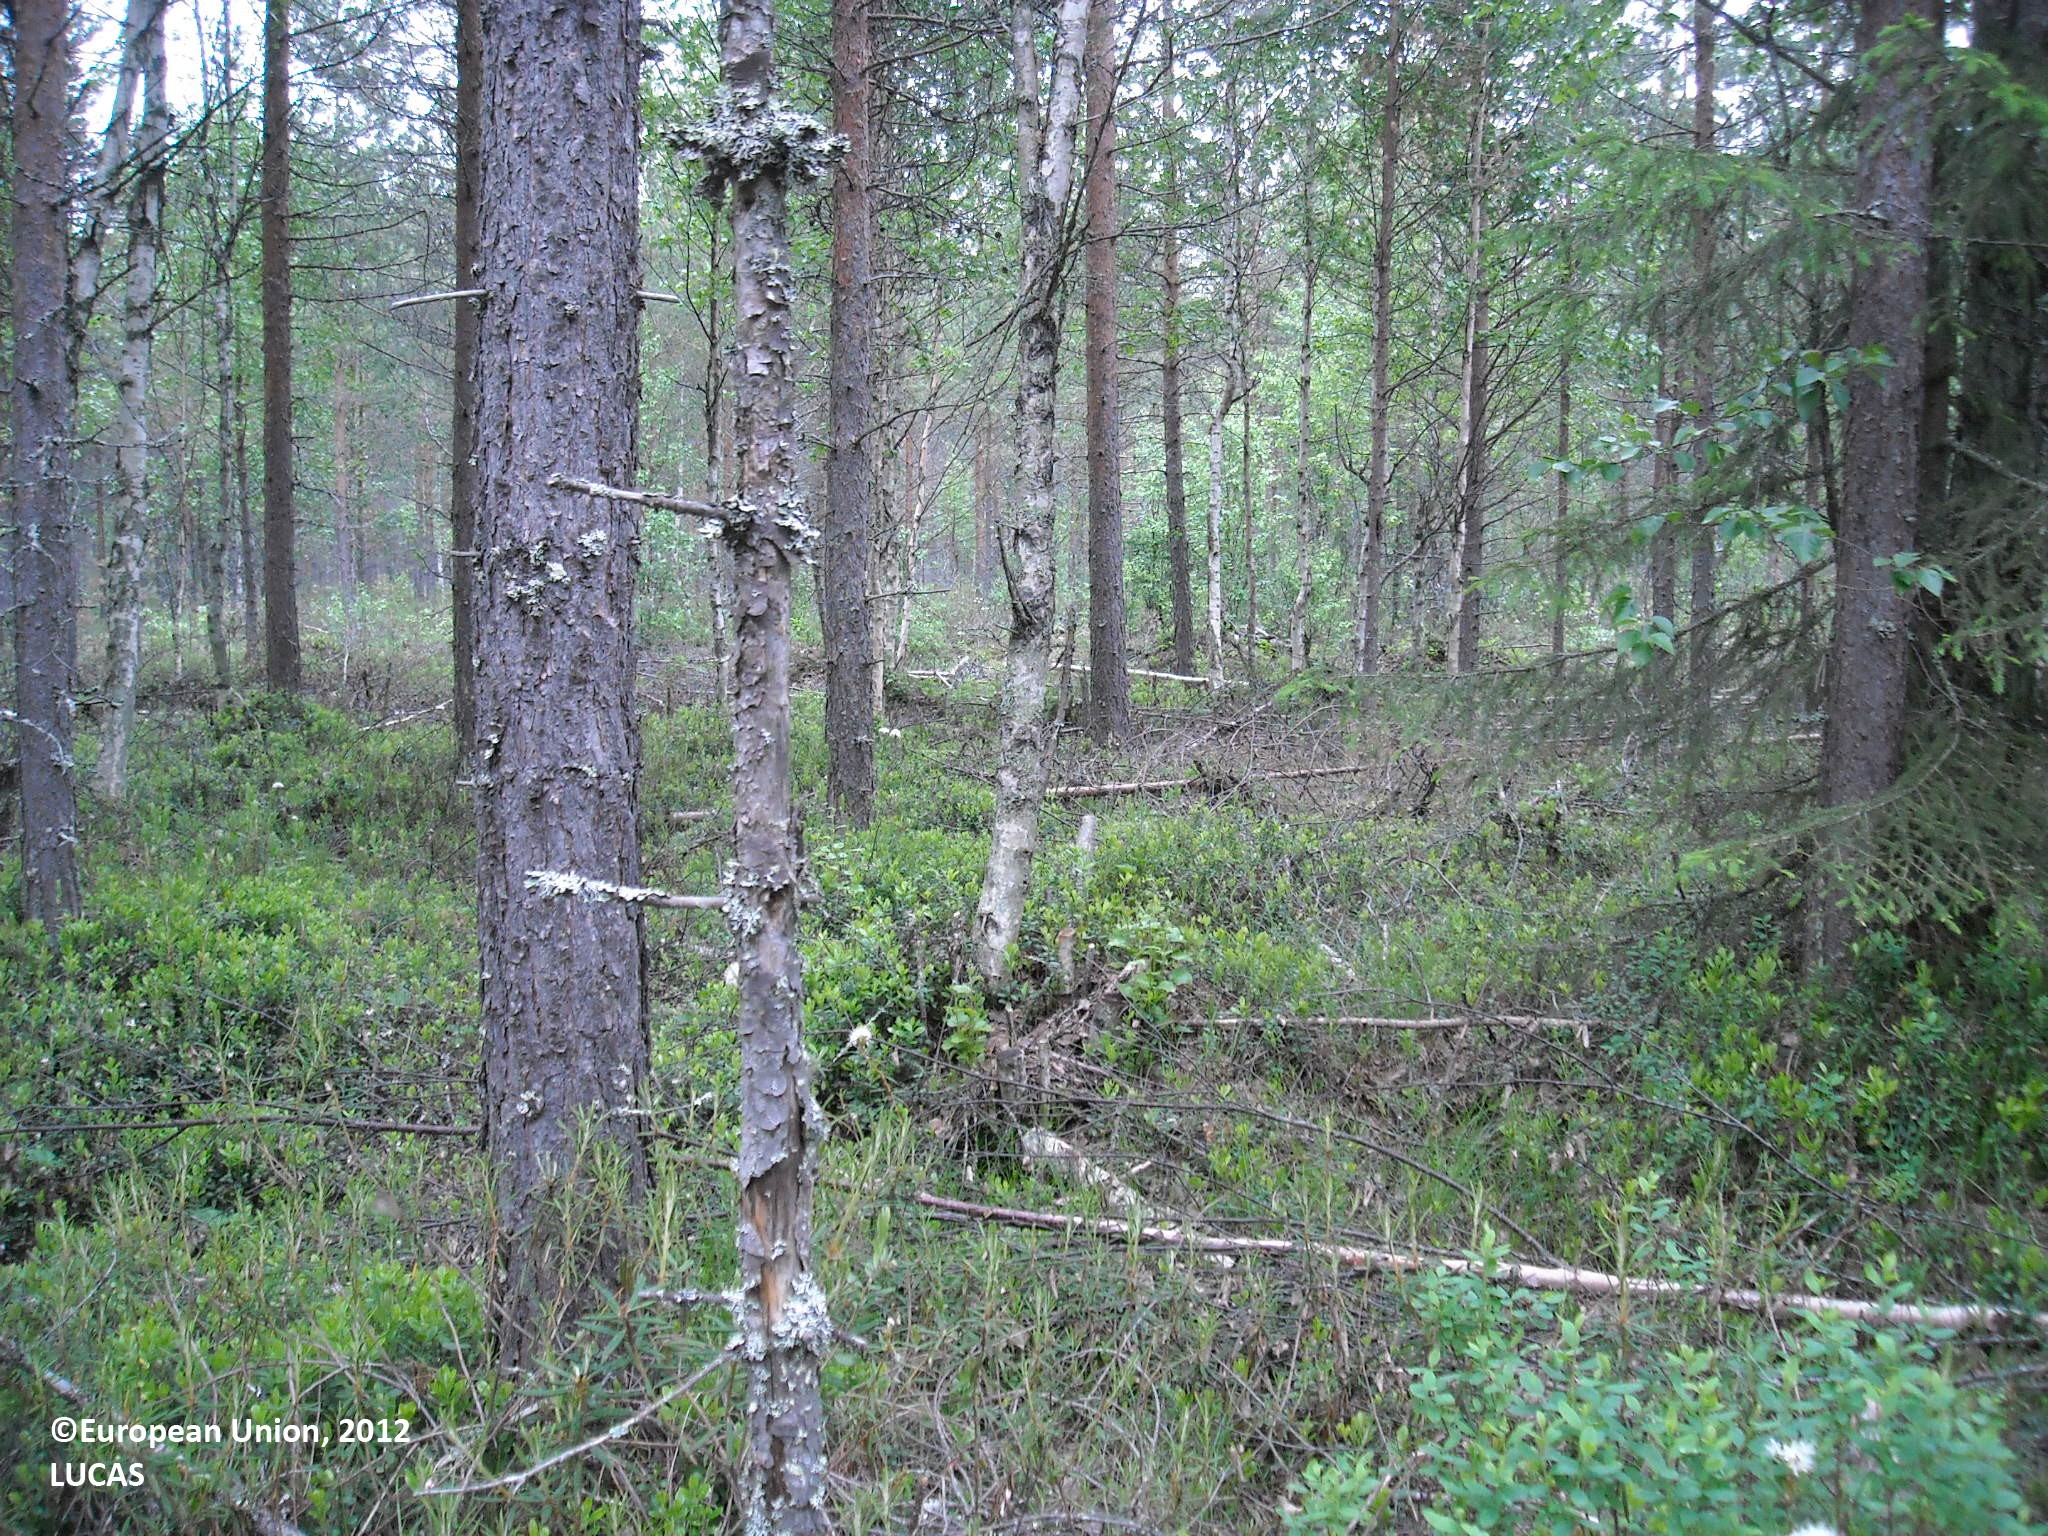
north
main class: Woodland
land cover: Pine dominated mixed woodland
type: mire and swamp forests
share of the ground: > 75 %
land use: Forestry
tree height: > 5 m
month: June
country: FI
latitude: 64.4866
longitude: 27.2185
